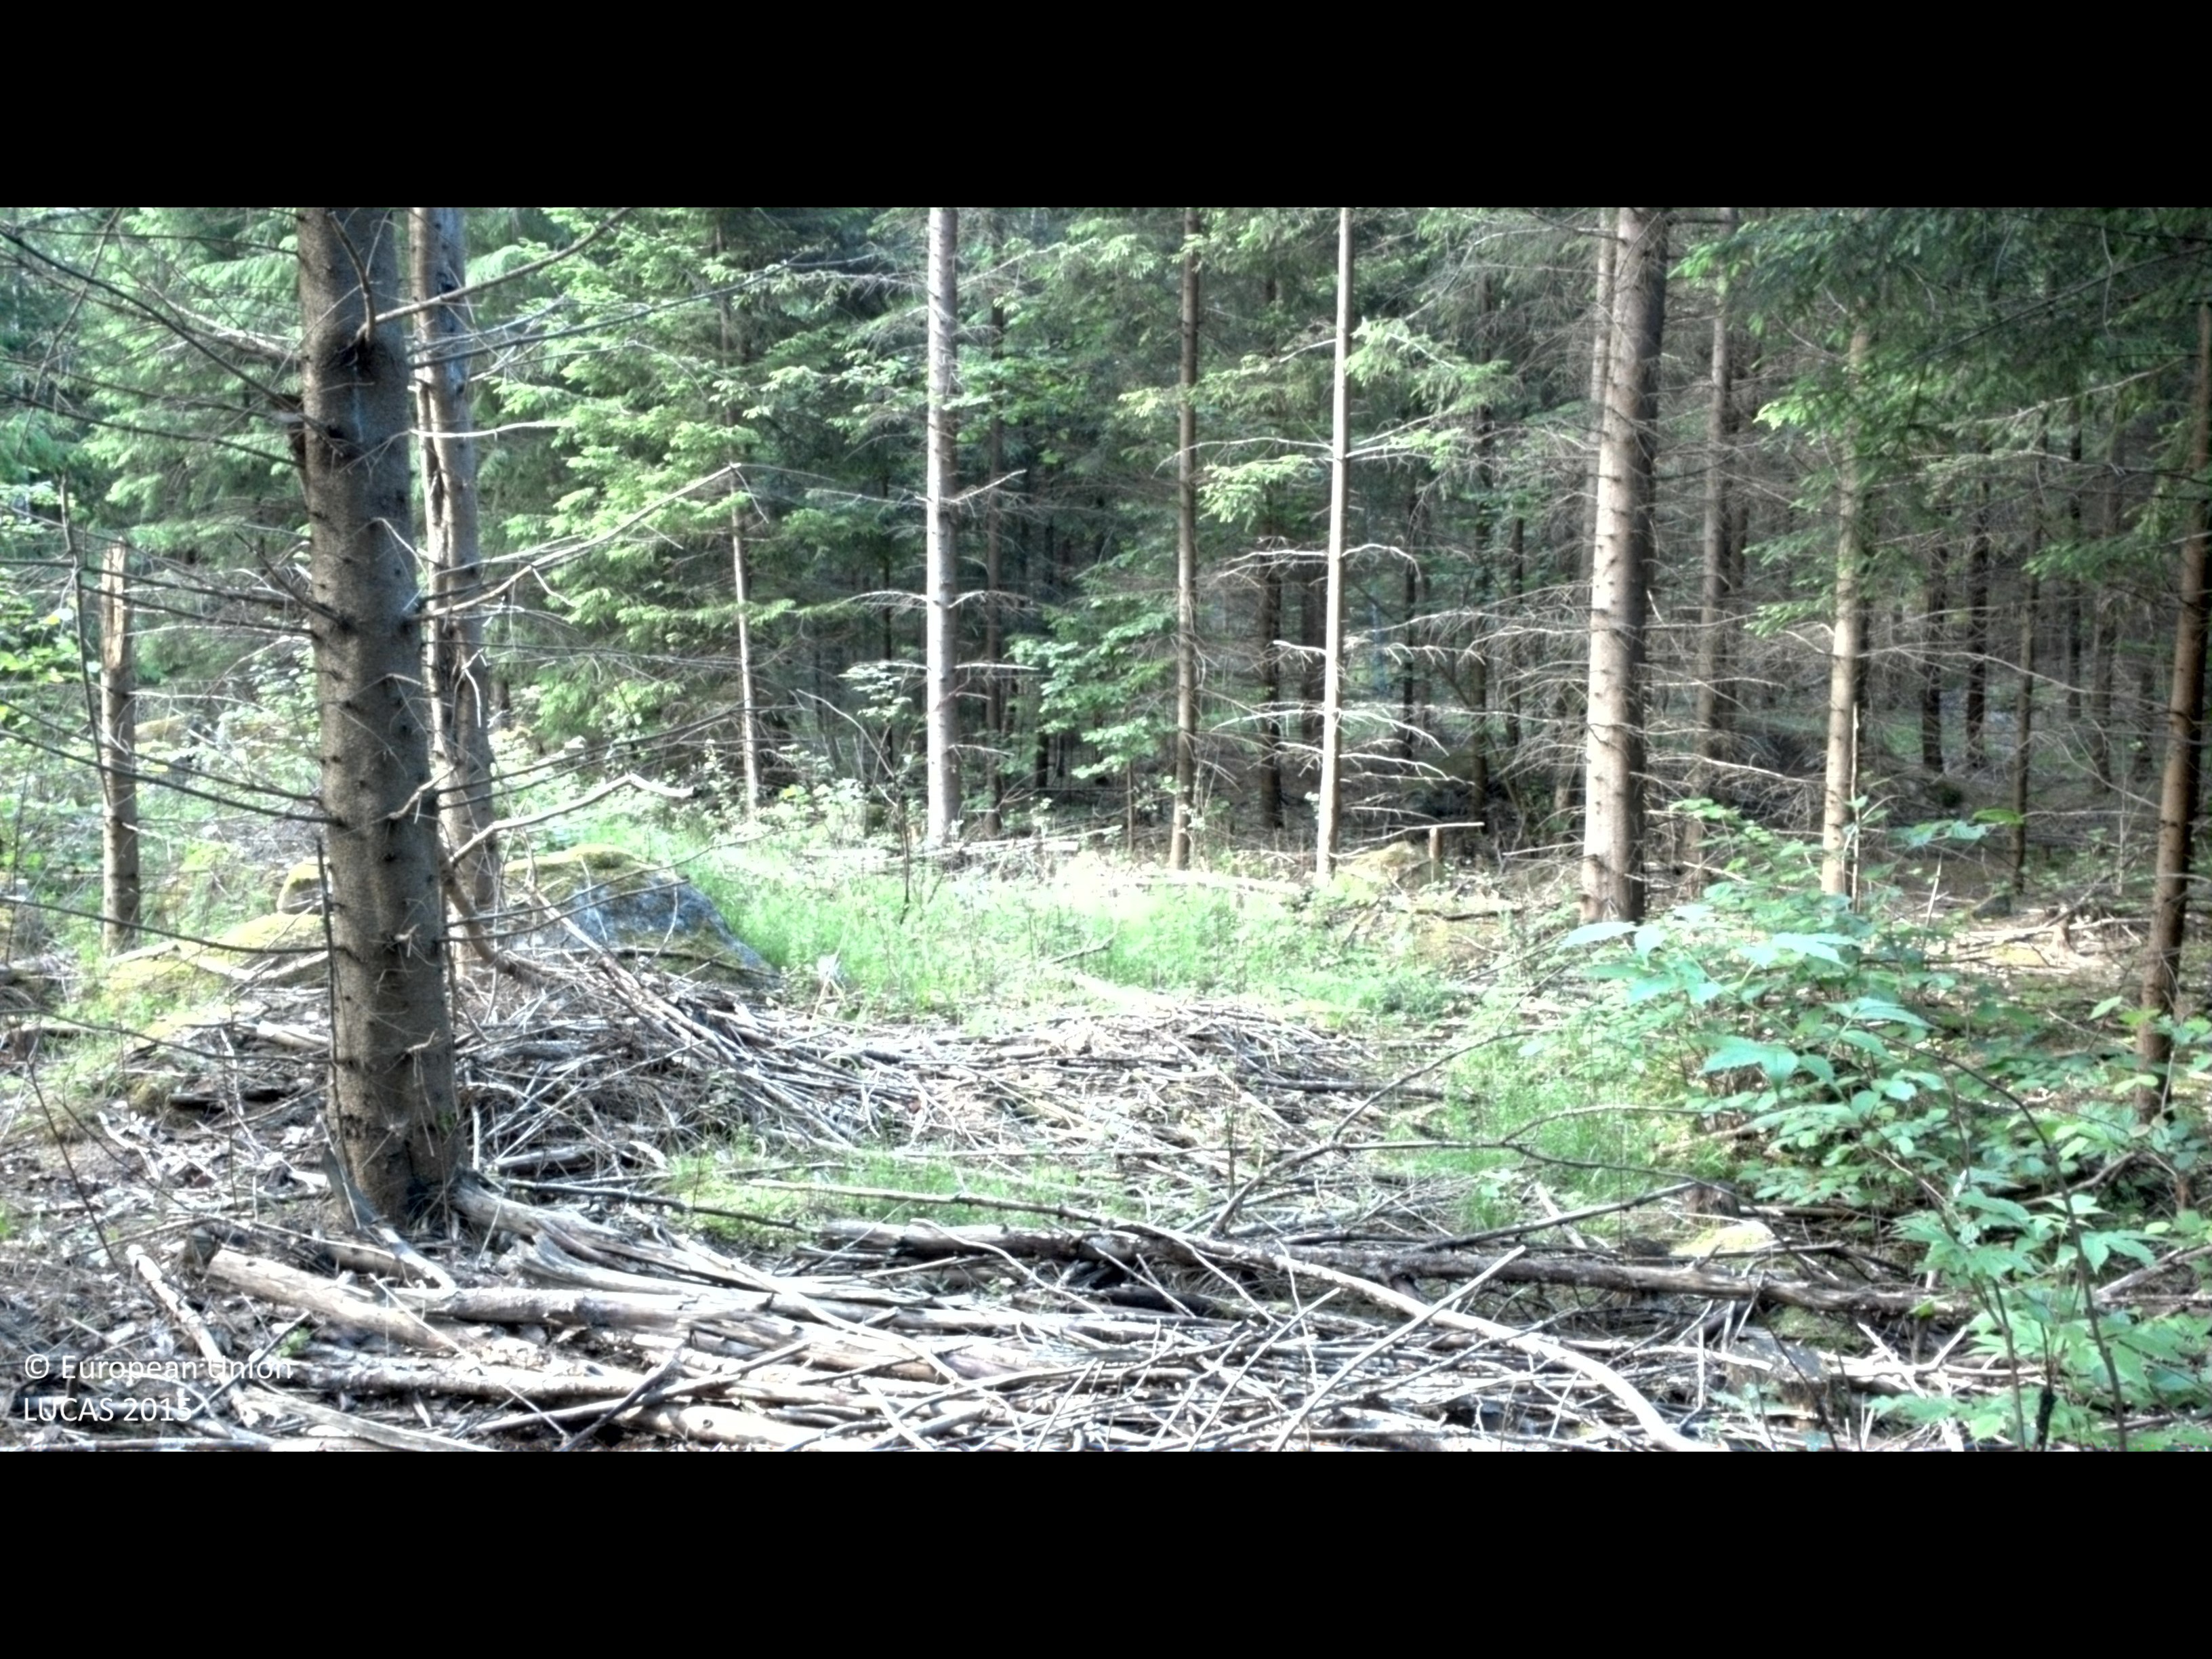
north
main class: Woodland
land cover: Spruce dominated coniferous woodland
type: boreal forest
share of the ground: > 75 %
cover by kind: coniferous forest trees 70 %, broadleaved forest trees 10 %, shrubs 10 %, herbaceous plants 5 %, lichens and mosses 5 %
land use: Forestry
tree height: > 5 m
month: June
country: SE
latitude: 58.2398
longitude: 16.1792
